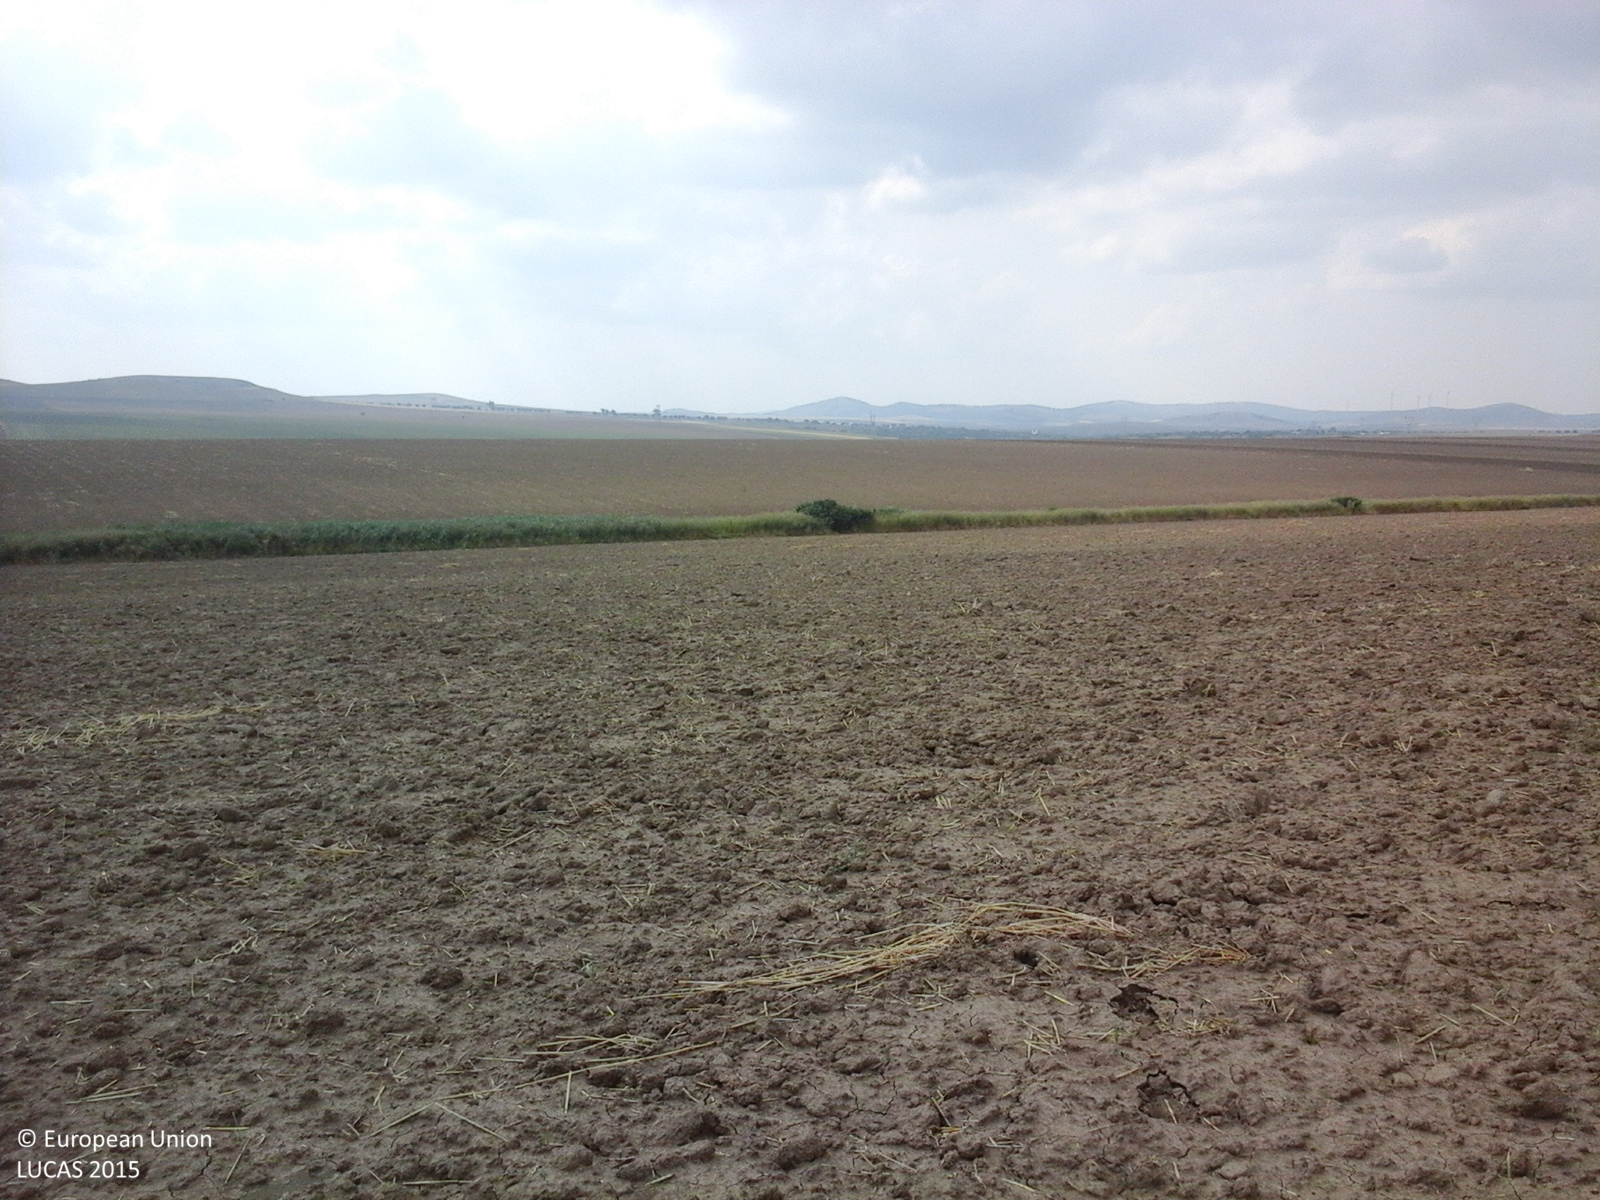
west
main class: Cropland
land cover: Oats
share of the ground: < 10 %
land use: Agriculture (excluding fallow land and kitchen gardens)
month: July
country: RO
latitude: 45.0241
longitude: 28.6506
